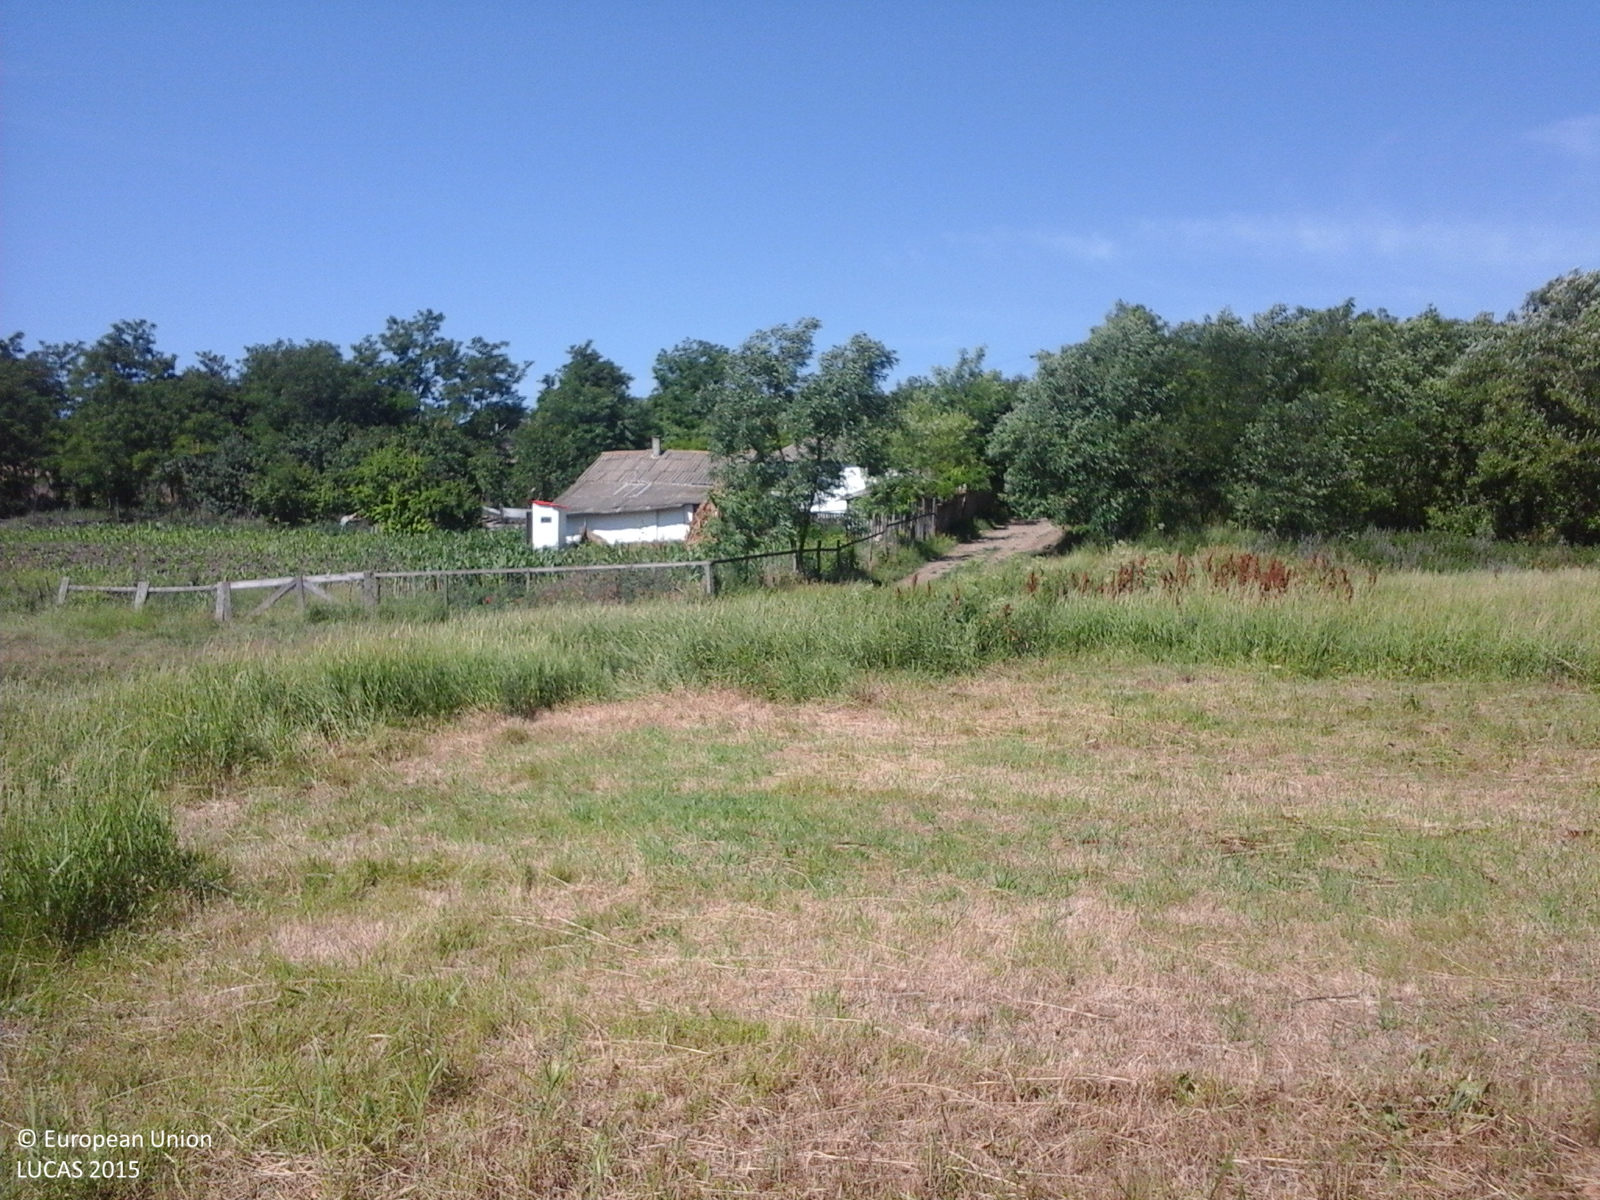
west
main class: Grassland
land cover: Grassland without tree/shrub cover
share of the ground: > 75 %
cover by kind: herbaceous plants 100 %
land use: Agriculture (excluding fallow land and kitchen gardens)
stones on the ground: < 10 %
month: June
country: RO
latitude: 47.7820
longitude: 26.8232
